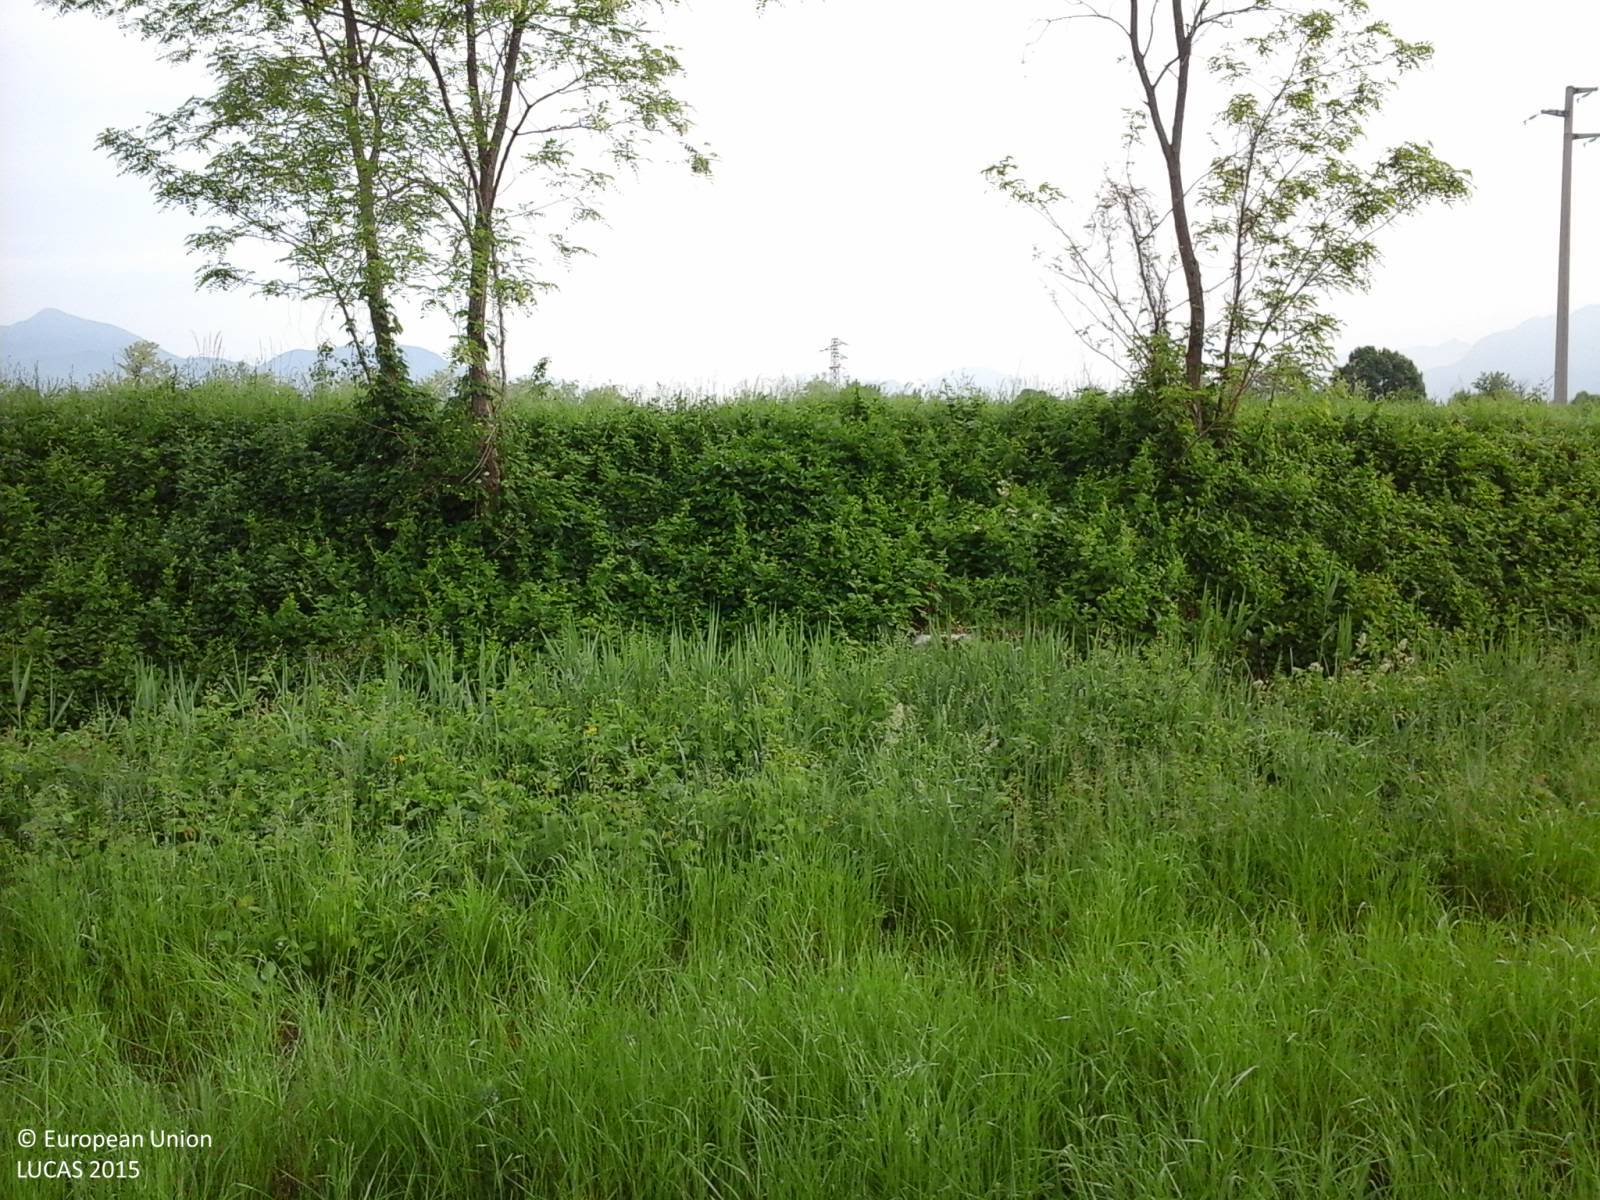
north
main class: Cropland
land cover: Temporary grasslands
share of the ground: > 75 %
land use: Agriculture (excluding fallow land and kitchen gardens)
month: May
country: IT
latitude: 46.1631
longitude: 13.0659
